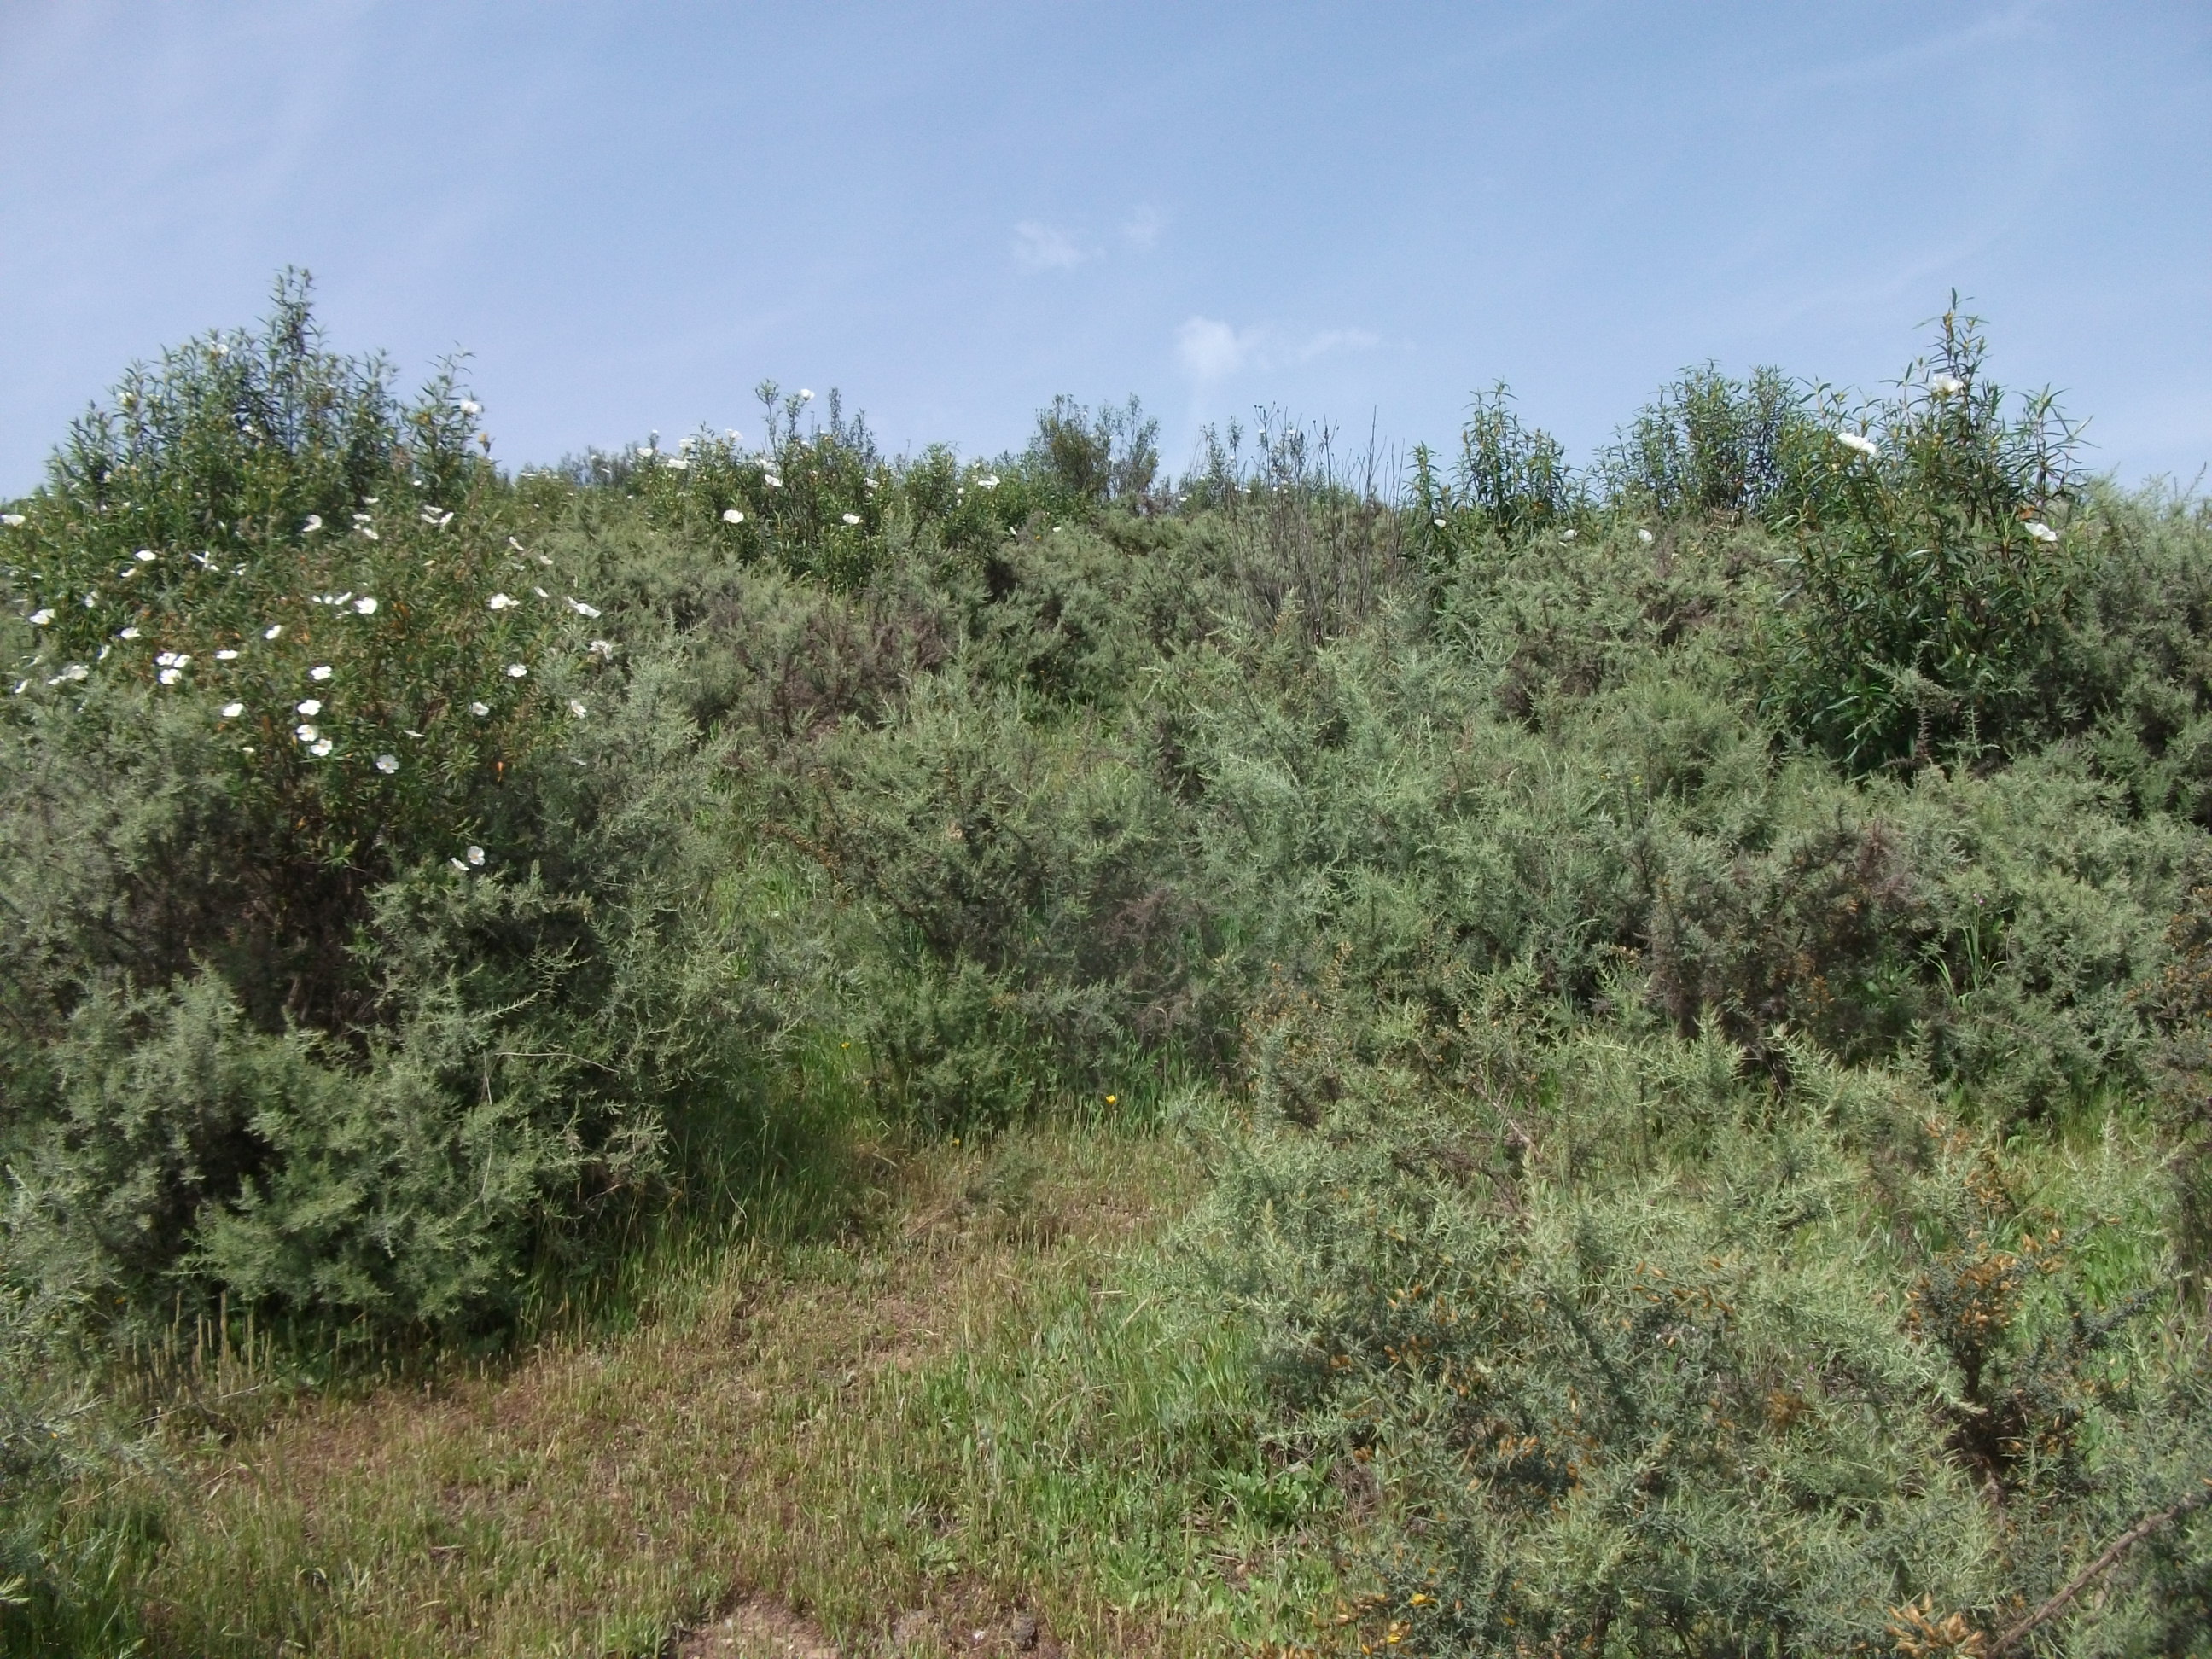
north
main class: Shrubland
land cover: Shrubland with sparse tree cover
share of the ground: > 75 %
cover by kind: shrubs 80 %, herbaceous plants 15 %, broadleaved forest trees 5 %
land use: Agriculture (excluding fallow land and kitchen gardens)
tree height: > 5 m
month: April
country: ES
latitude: 37.8265
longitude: -6.7119
